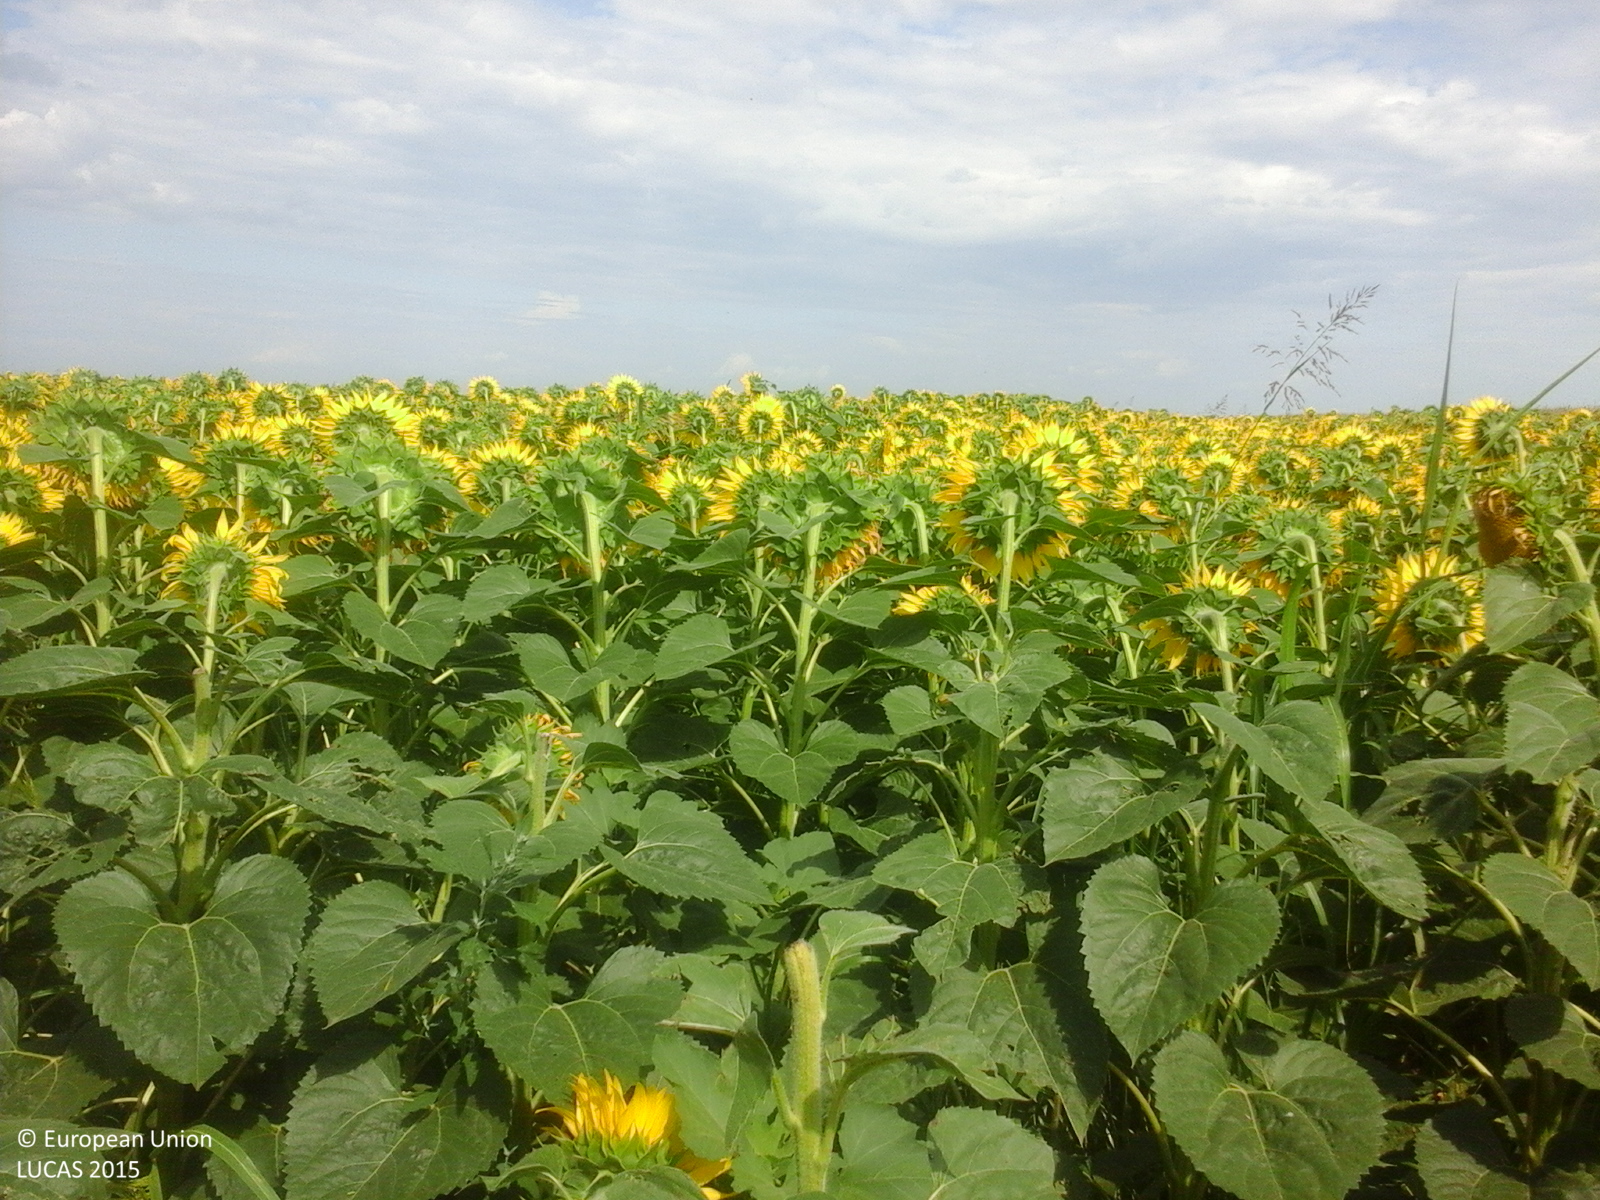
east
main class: Cropland
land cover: Sunflower
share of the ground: > 75 %
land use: Agriculture (excluding fallow land and kitchen gardens)
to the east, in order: Sunflower; Common wheat; Spontaneously vegetated surfaces; Common wheat
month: July
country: RO
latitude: 43.7909
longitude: 25.2023
